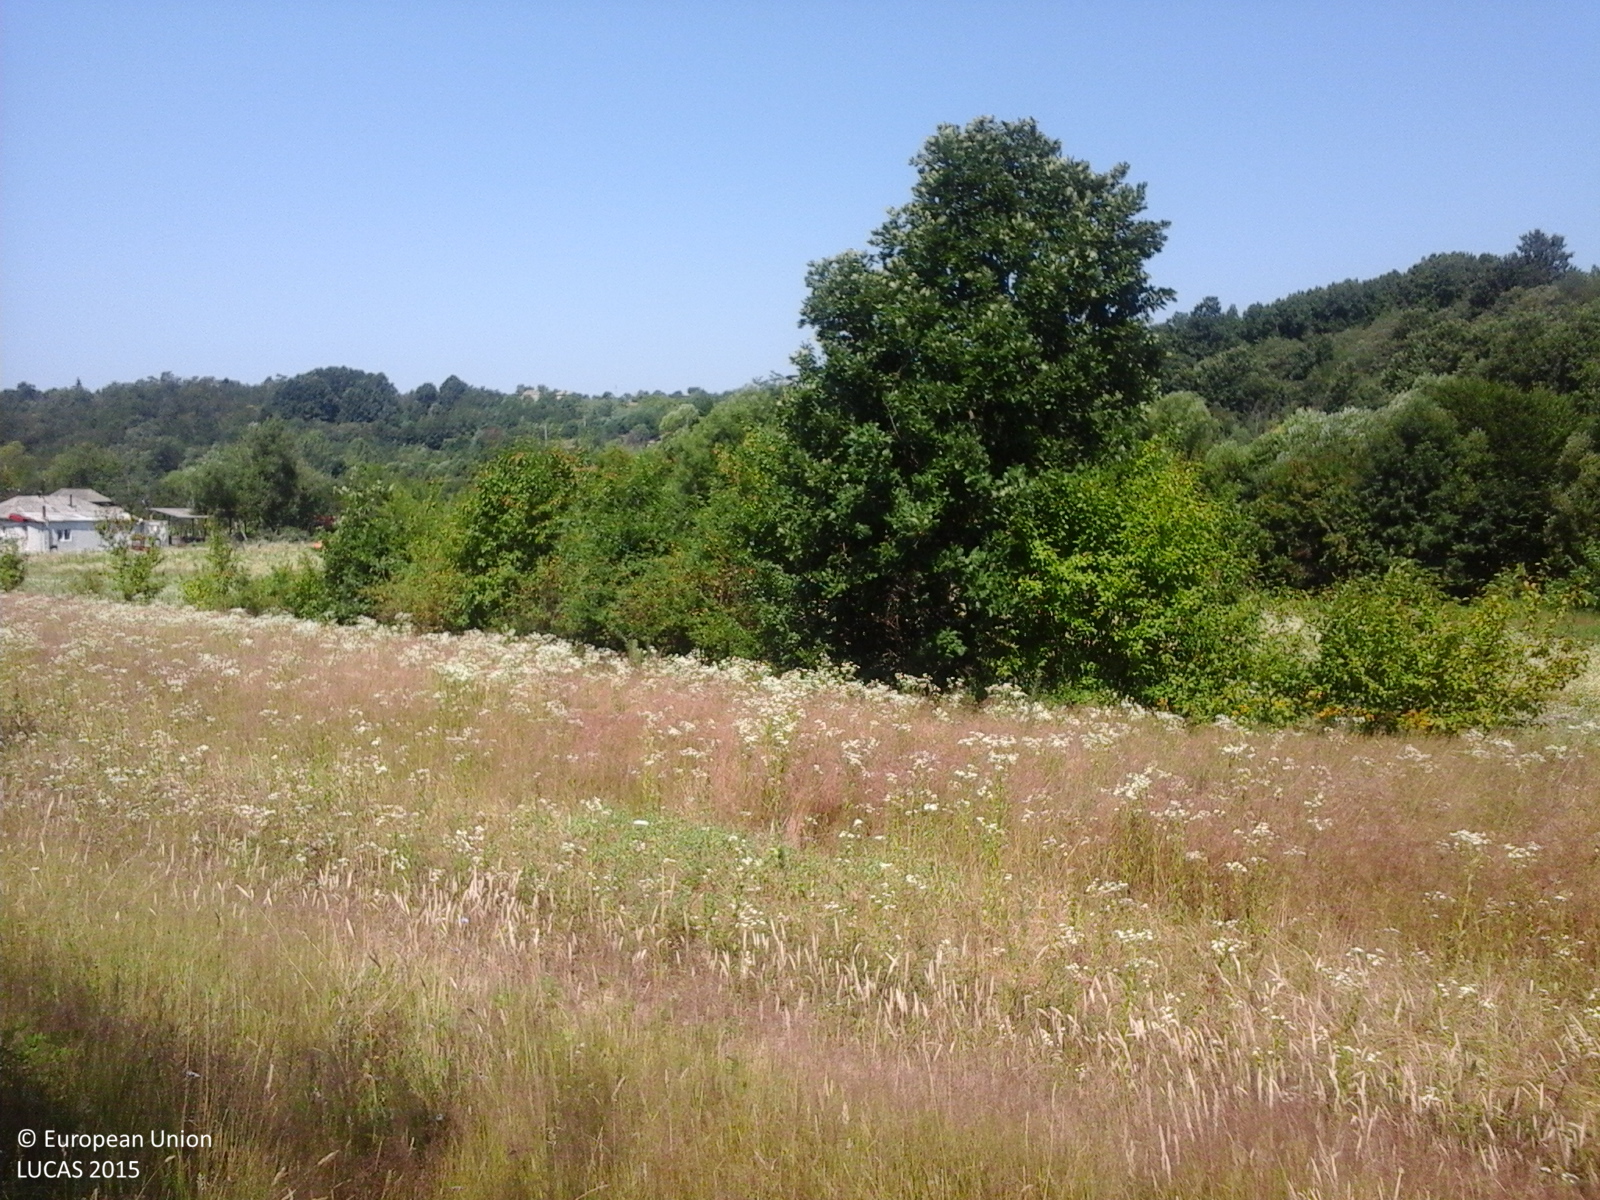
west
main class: Woodland
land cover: Broadleaved woodland
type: thermophilous deciduous forest
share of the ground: > 75 %
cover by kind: broadleaved forest trees 100 %
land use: Forestry
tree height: > 5 m
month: July
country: RO
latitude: 44.8397
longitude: 24.5344
